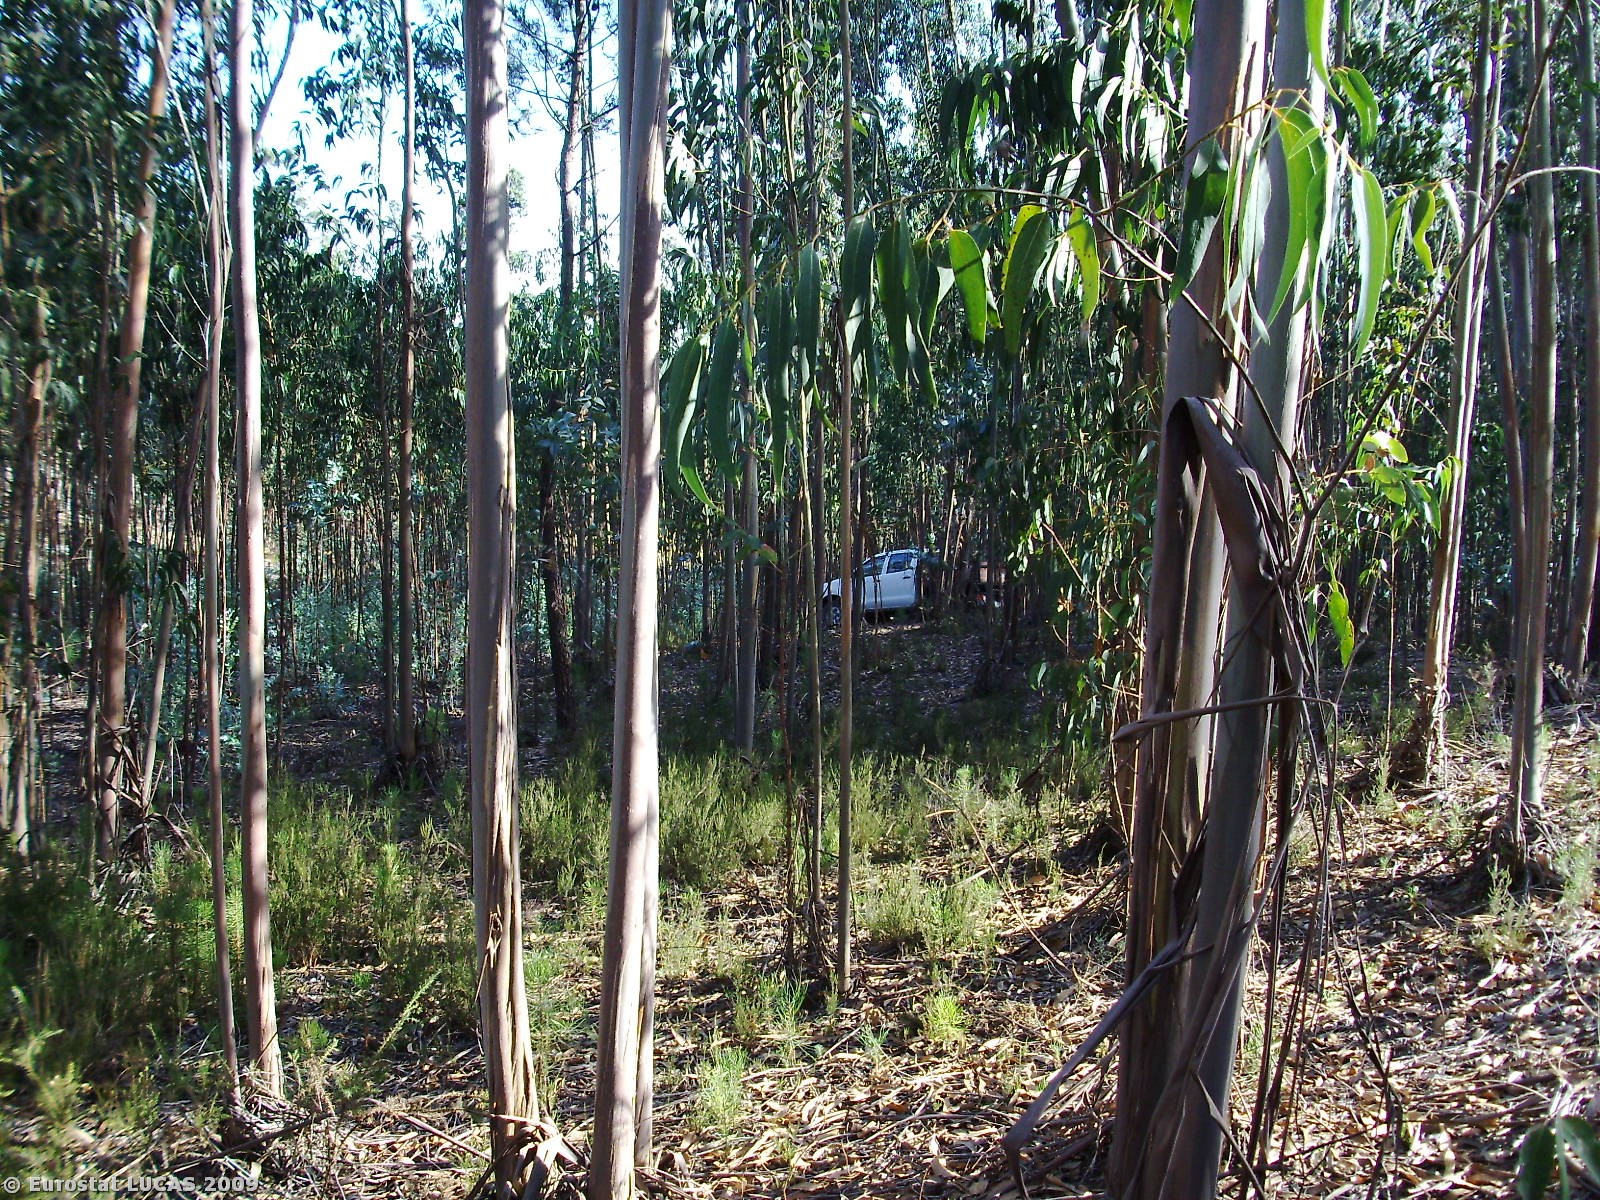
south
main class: Woodland
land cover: Broadleaved woodland
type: plantations and self-sown exotic forest
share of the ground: 50 - 75 %
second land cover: Bare land
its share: 25 - 50 %
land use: Forestry
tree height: > 5 m
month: July
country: PT
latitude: 39.3662
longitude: -8.8478
